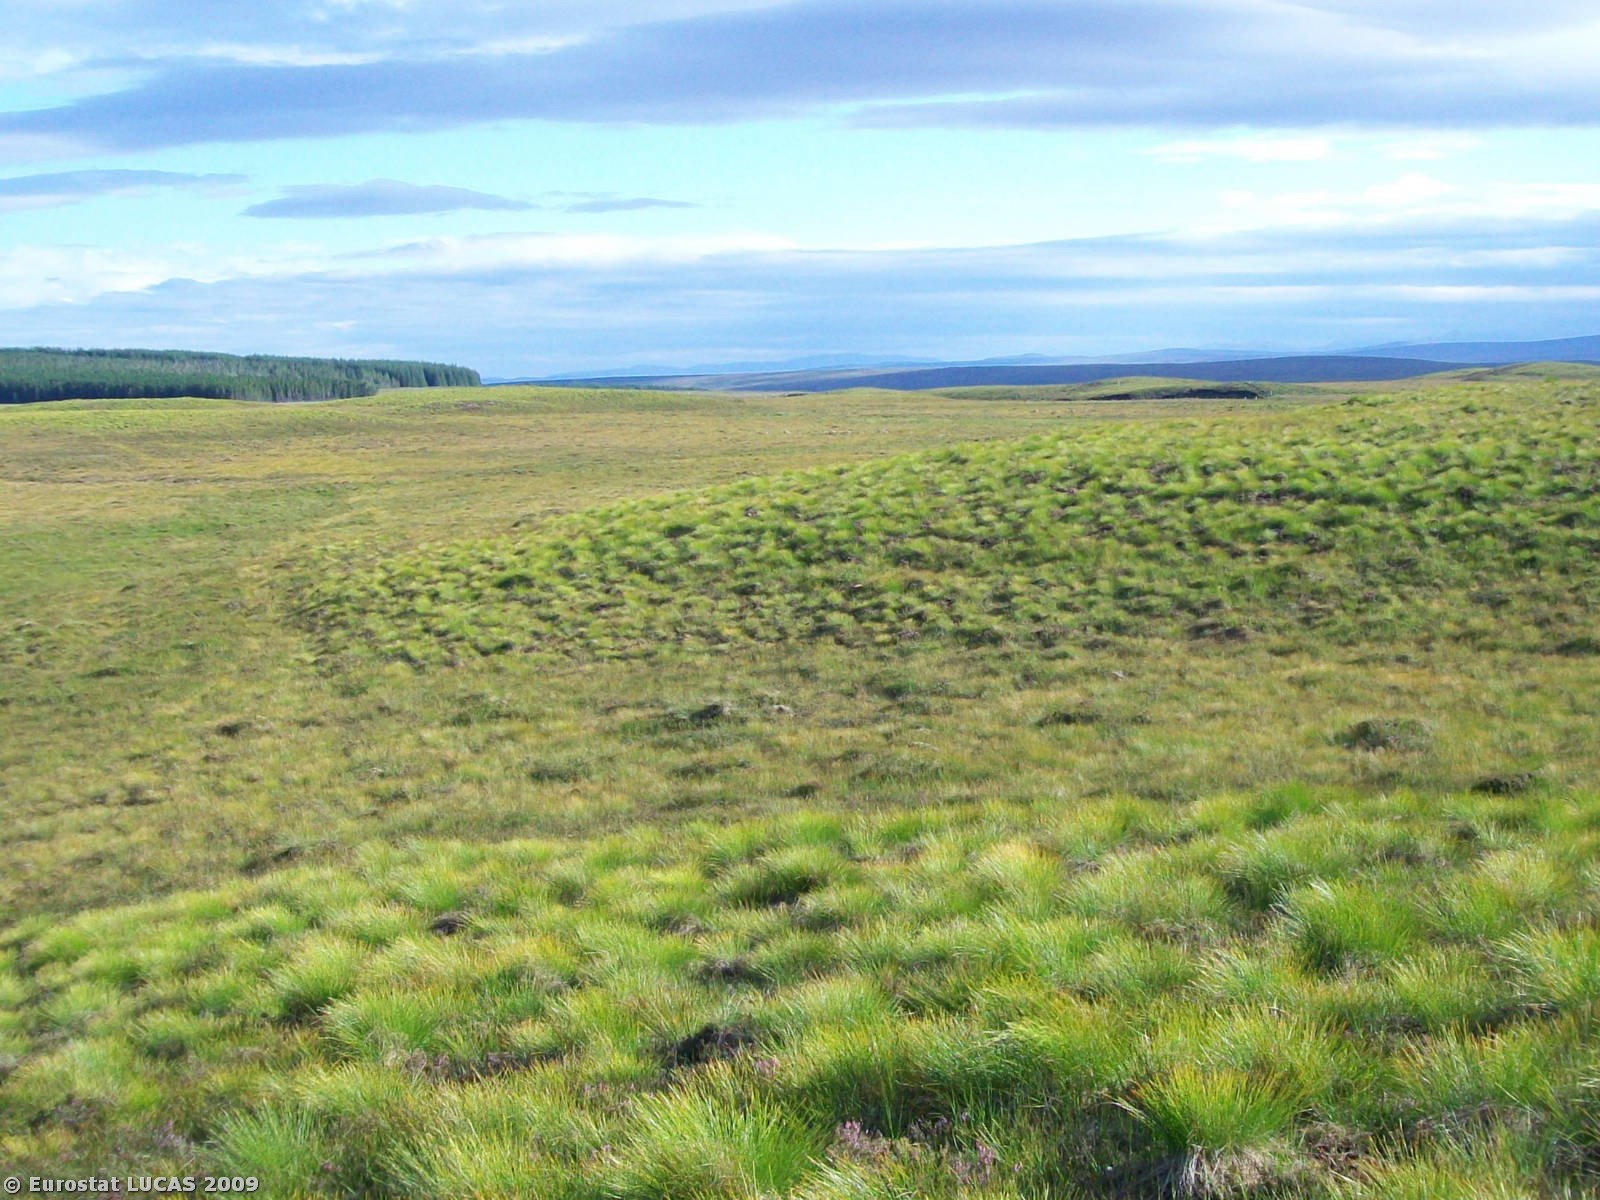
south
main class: Shrubland
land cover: Shrubland without tree cover
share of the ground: > 75 %
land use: Fallow land
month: August
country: GB
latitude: 58.1935
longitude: -4.5301
